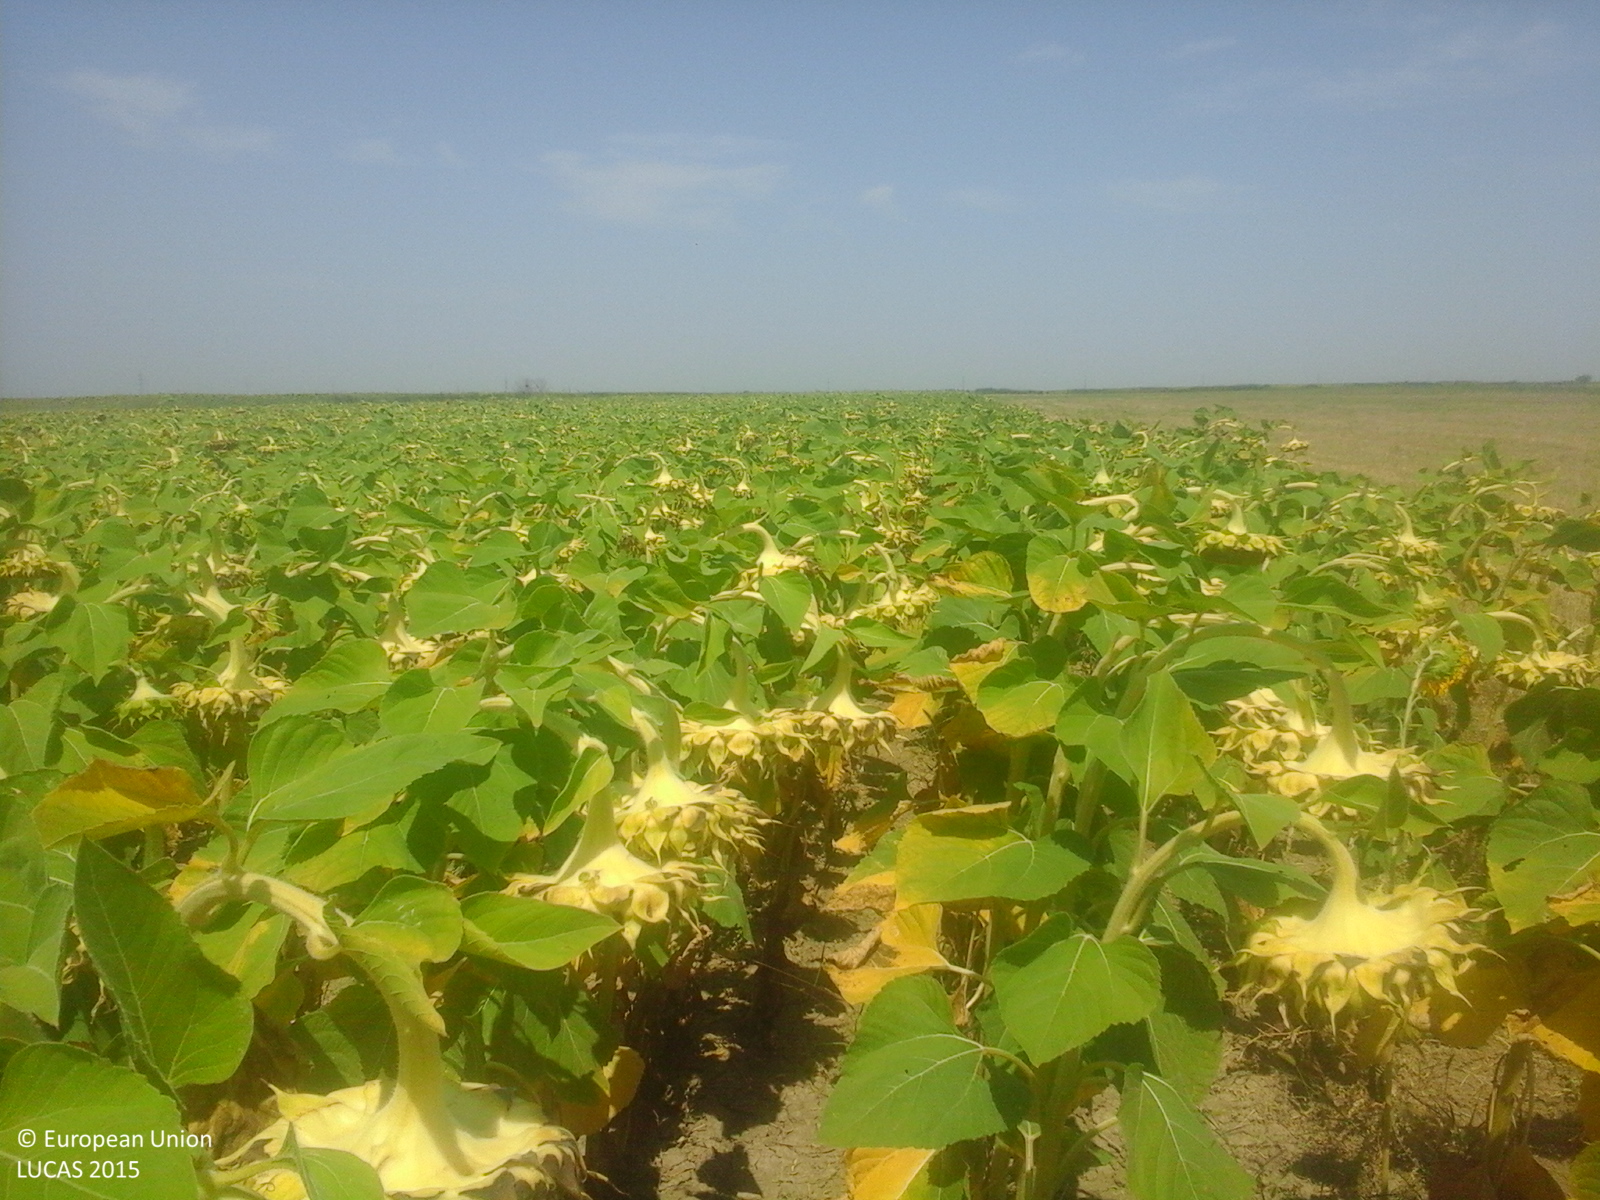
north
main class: Cropland
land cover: Sunflower
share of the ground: > 75 %
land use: Agriculture (excluding fallow land and kitchen gardens)
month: August
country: RO
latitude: 45.5451
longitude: 27.3505
